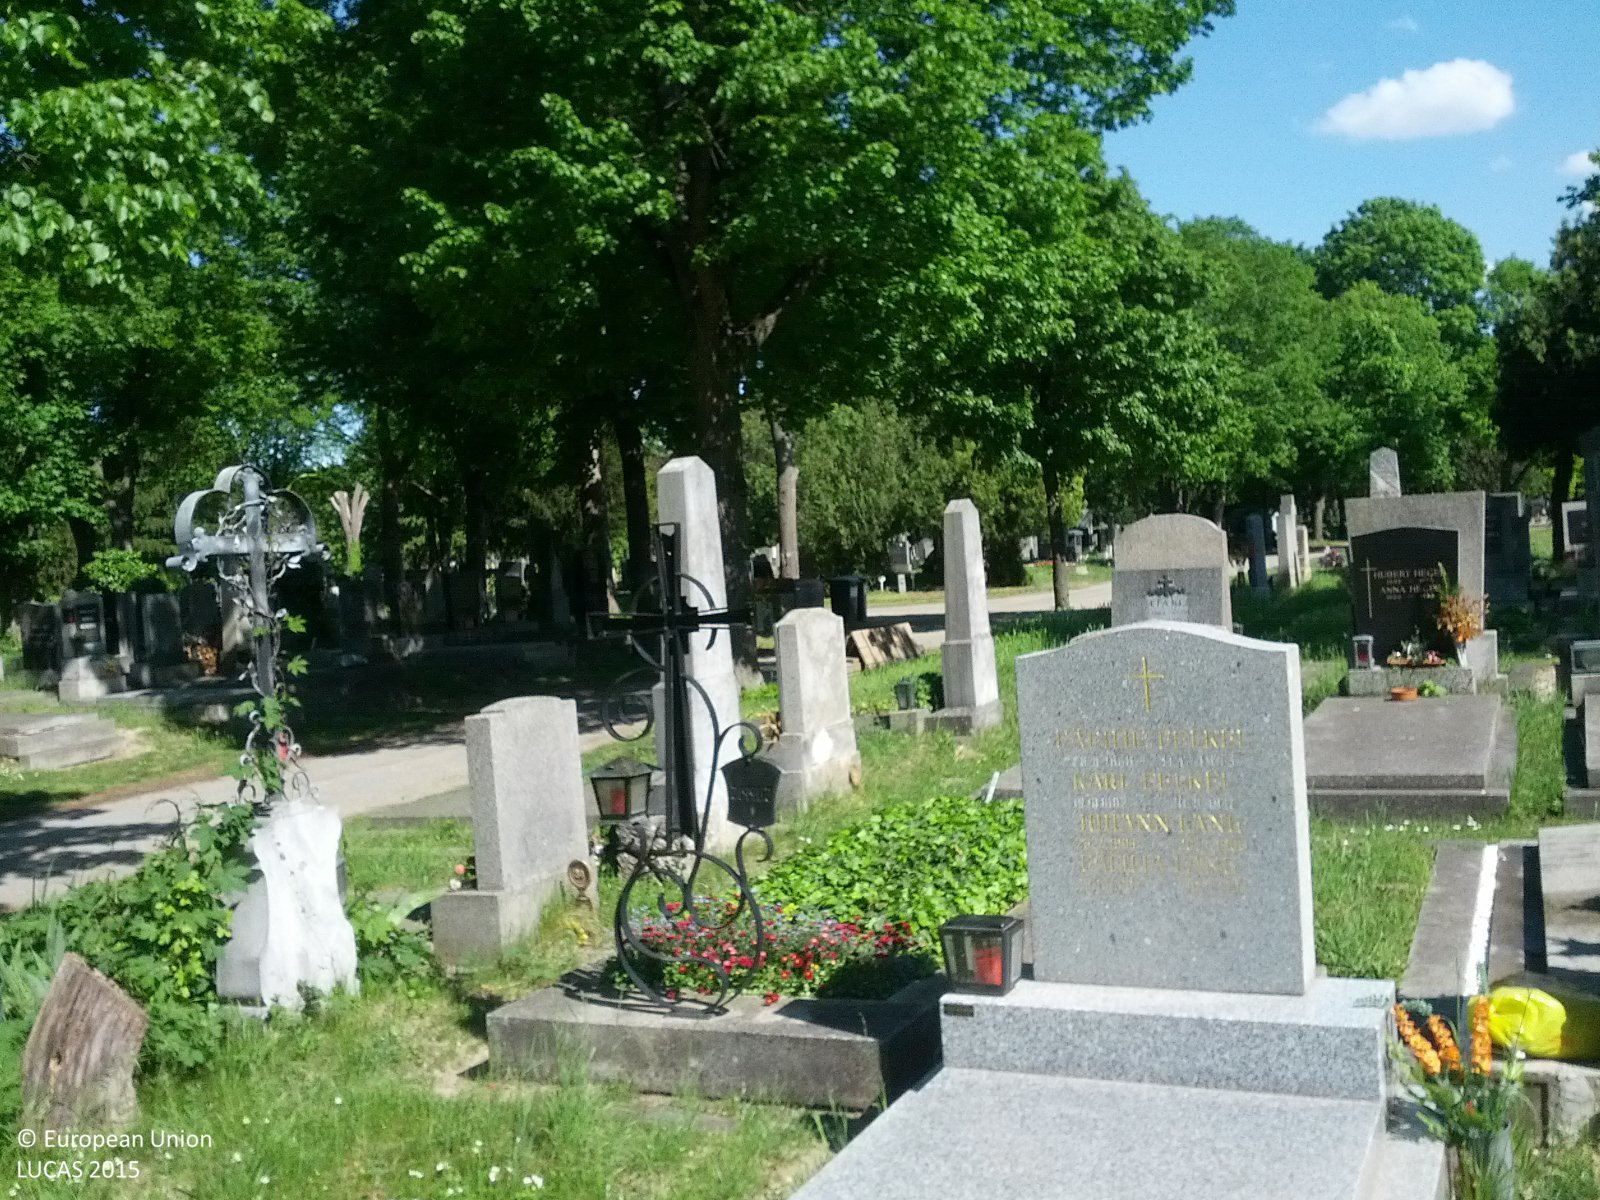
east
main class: Woodland
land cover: Broadleaved woodland
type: mesophytic deciduous forest
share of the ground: < 10 %
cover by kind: herbaceous plants 70 %, broadleaved forest trees 15 %, consolidated bare surface 15 %
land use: Community services
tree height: > 5 m
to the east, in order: Broadleaved woodland; Artificial constructions in urban areas
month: May
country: AT
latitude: 48.1434
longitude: 16.4428
